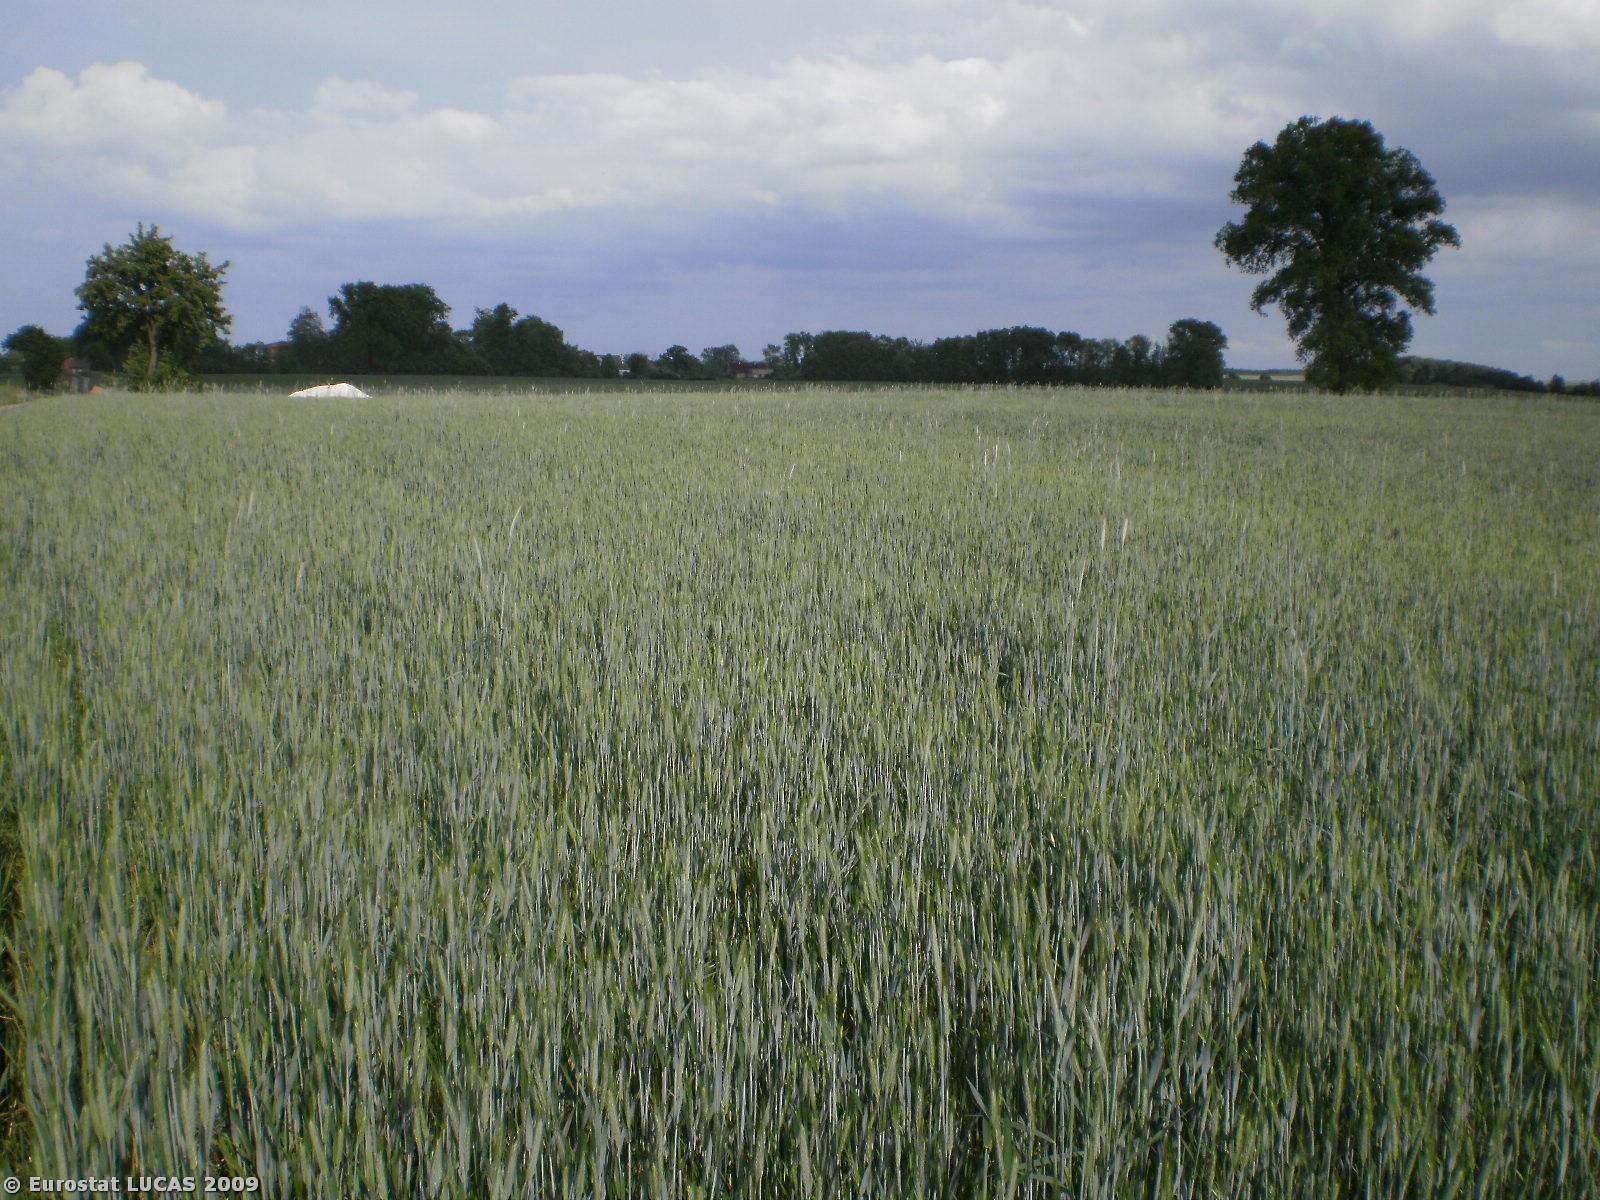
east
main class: Cropland
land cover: Triticale
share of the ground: > 75 %
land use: Agriculture (excluding fallow land and kitchen gardens)
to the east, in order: Triticale; Single bushes/trees; Ditches and canals; Triticale
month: May
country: PL
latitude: 53.2826
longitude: 17.7075
